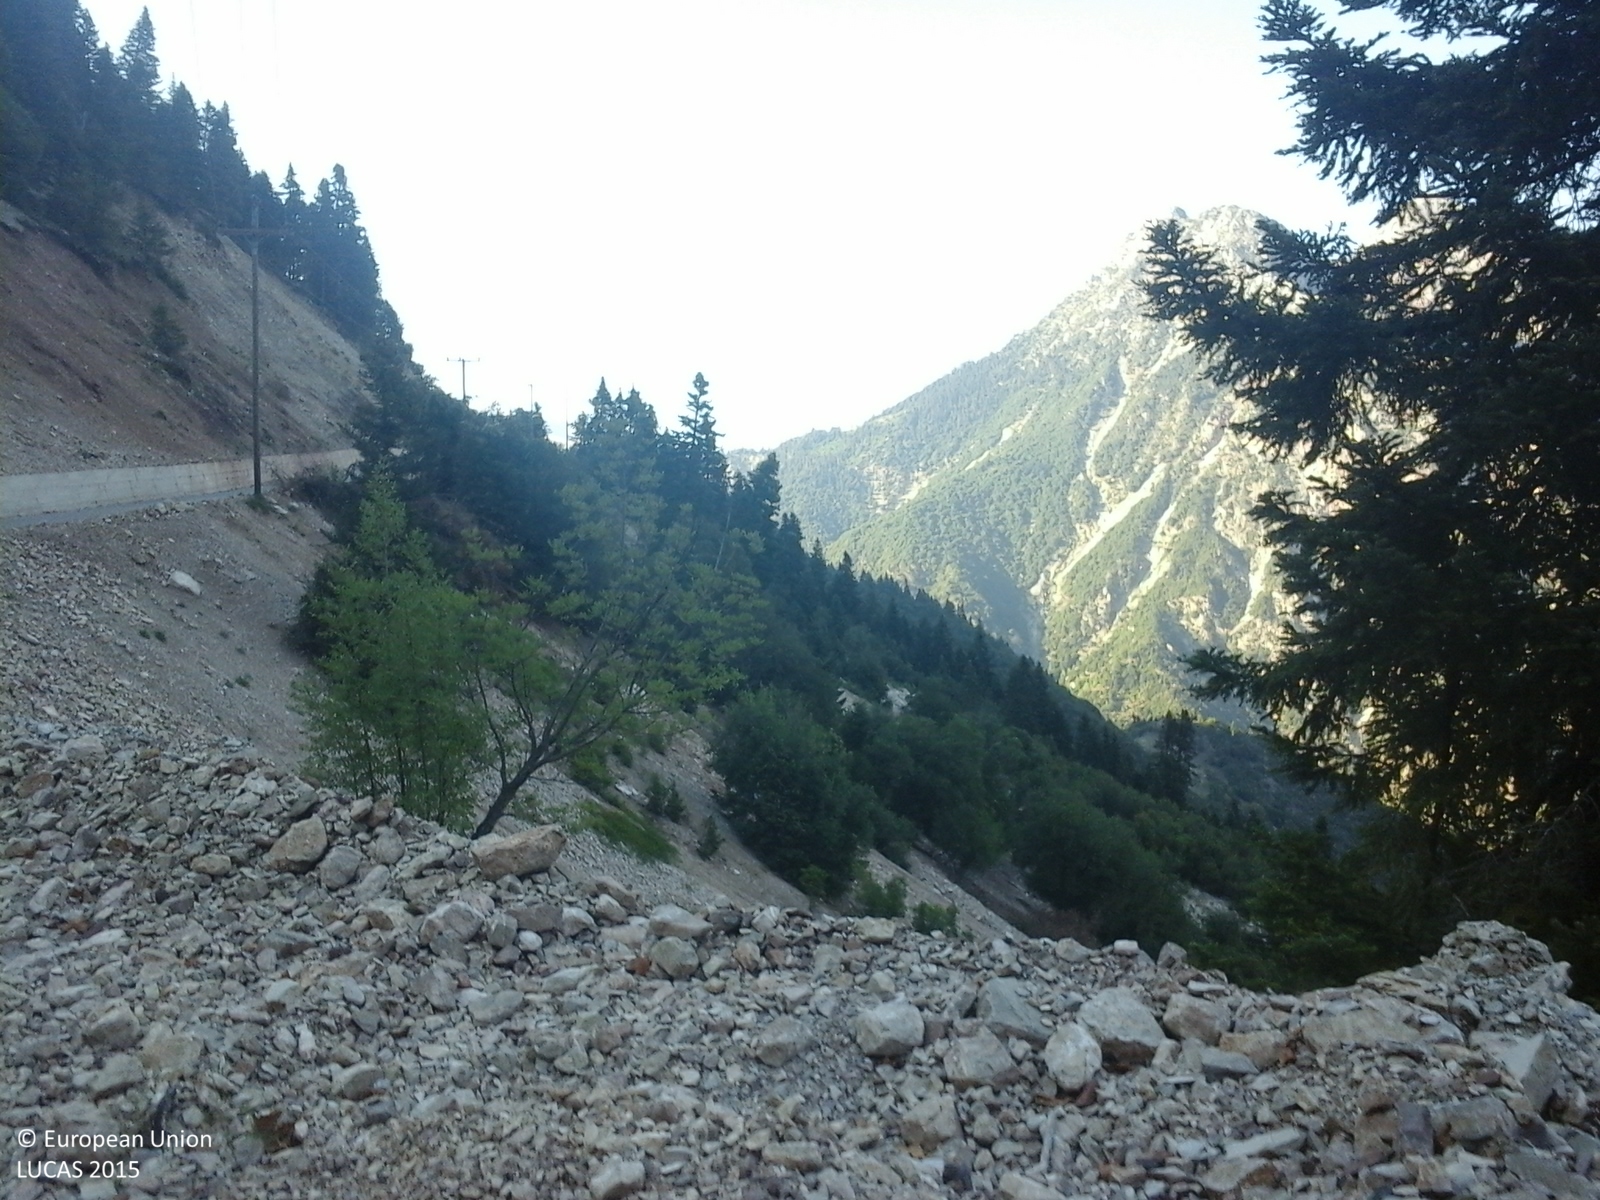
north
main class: Woodland
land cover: Spruce dominated coniferous woodland
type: coniferous forest of the mediterranean region
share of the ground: > 75 %
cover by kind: coniferous forest trees 75 %, unconsolidated bare surface 25 %
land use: Semi-natural and natural areas not in use
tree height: > 5 m
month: August
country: GR
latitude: 38.7428
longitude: 21.6970
